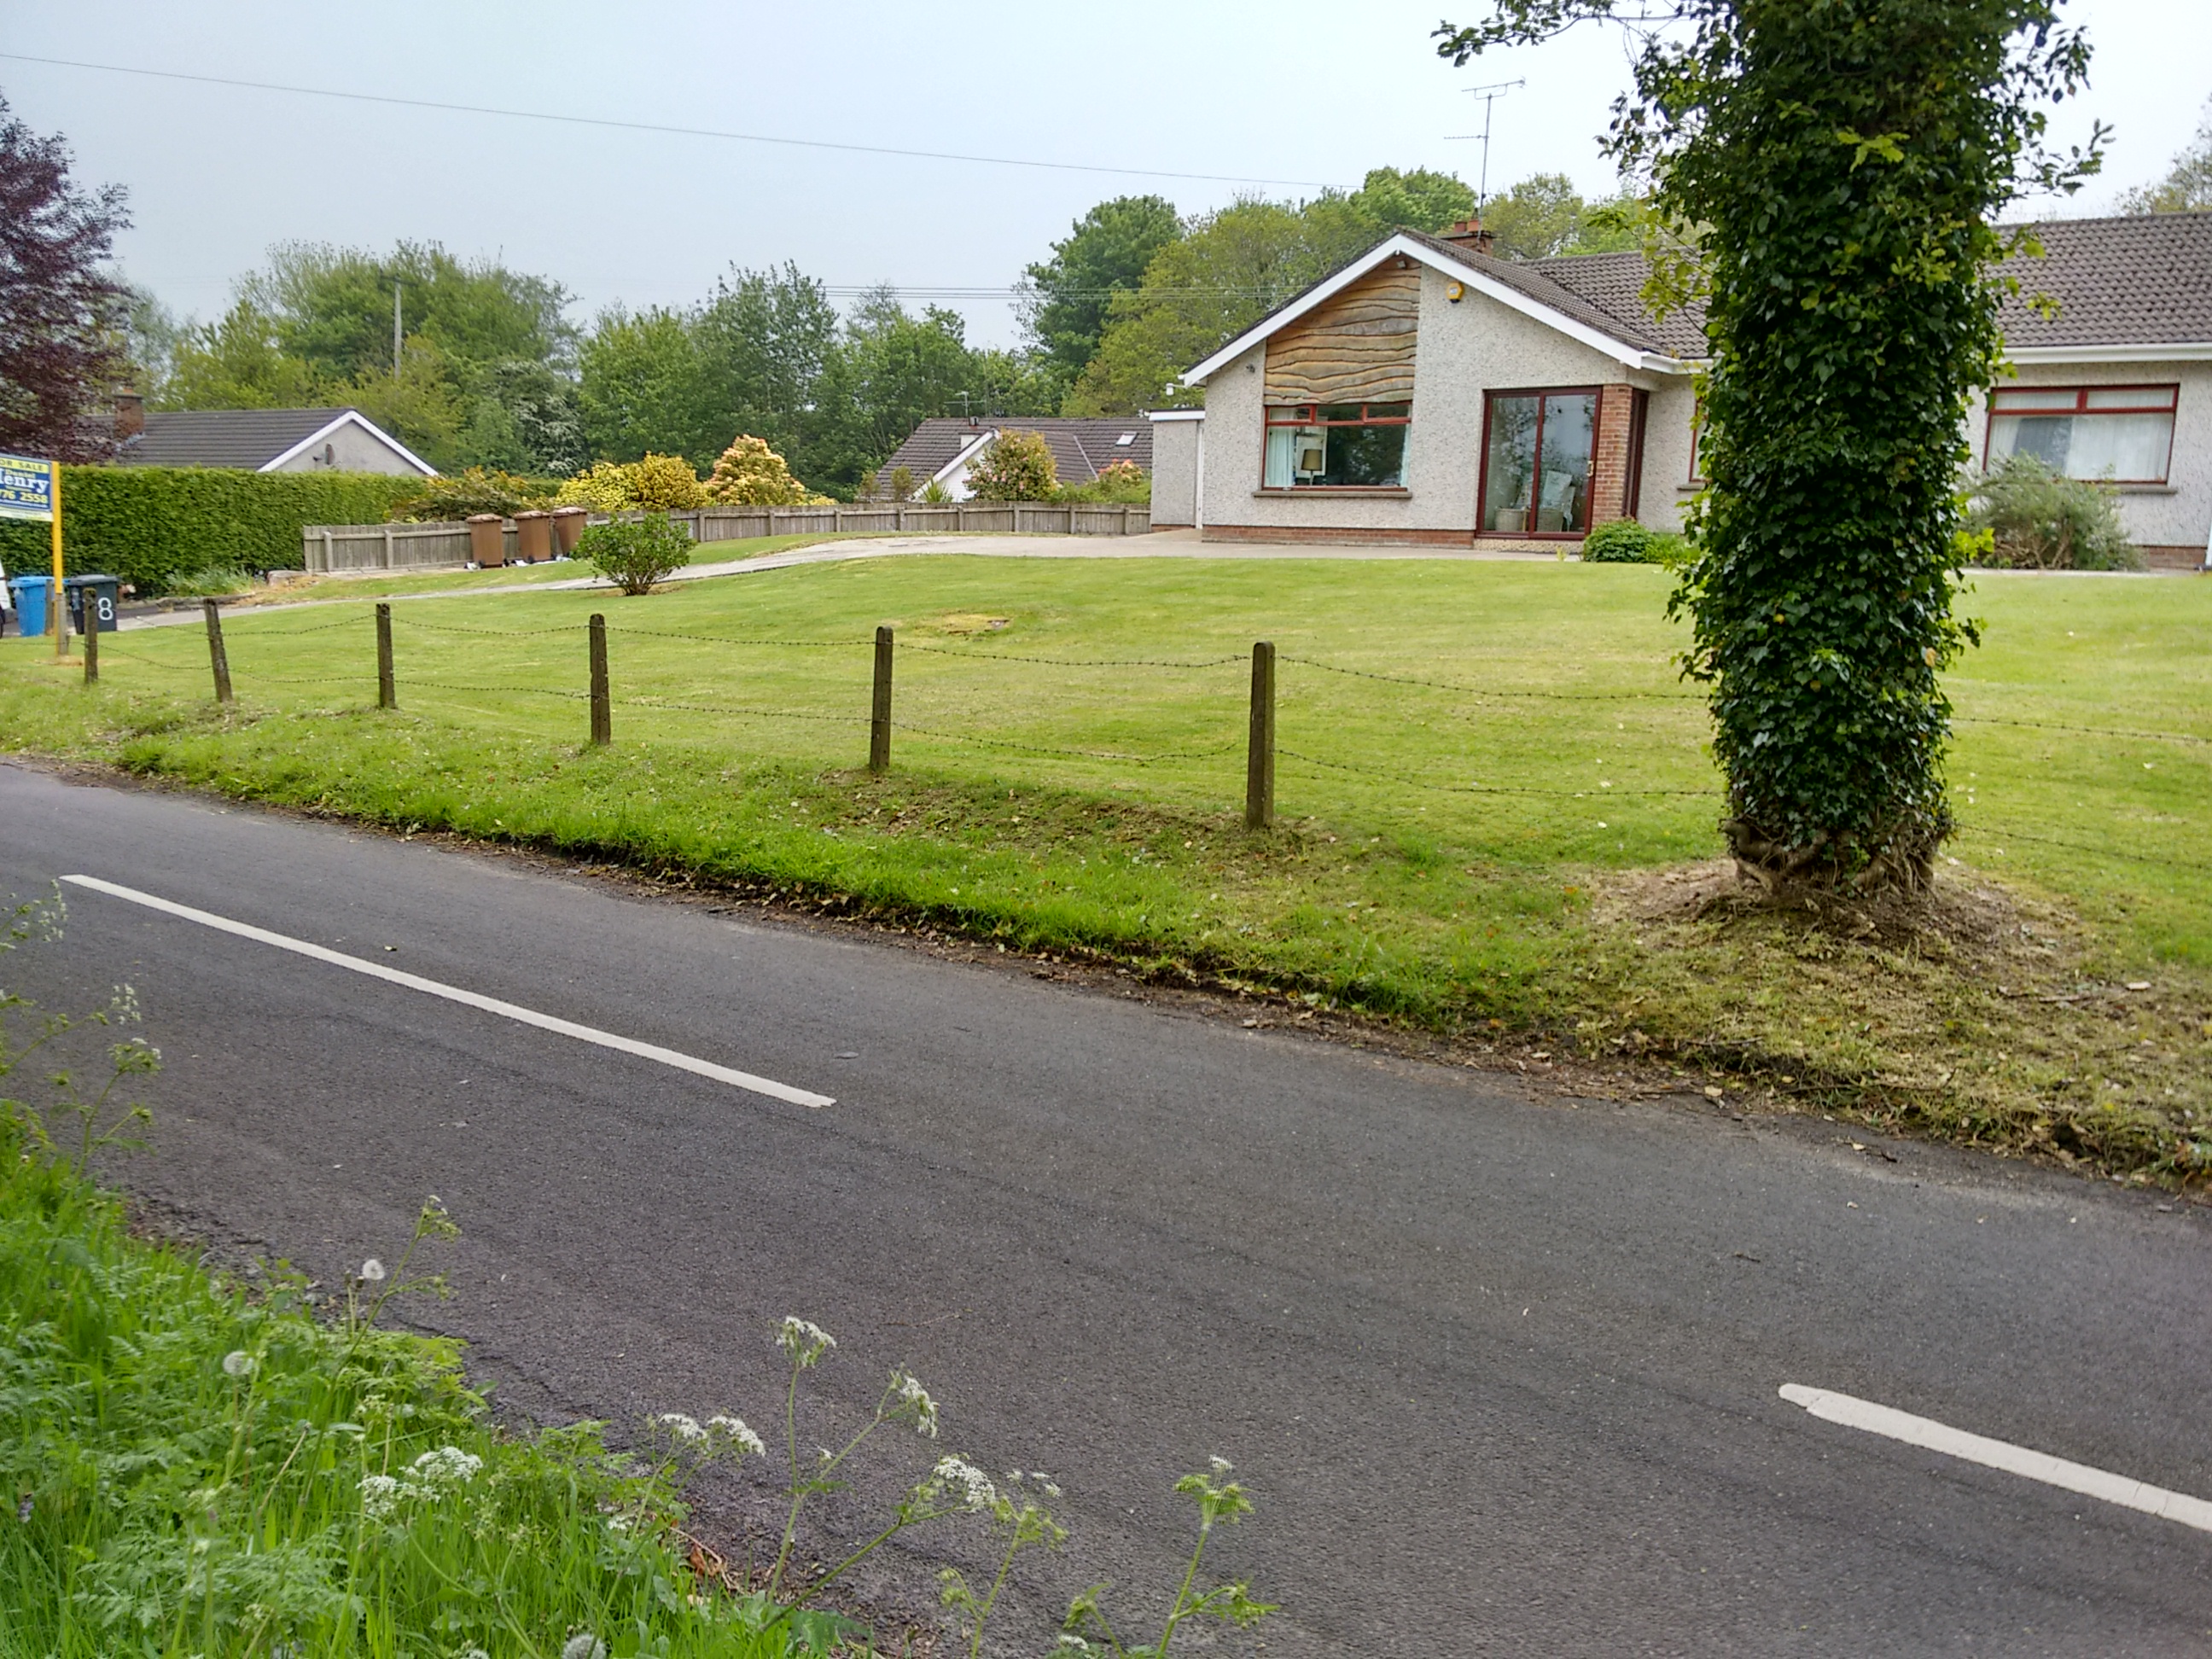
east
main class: Woodland
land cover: Broadleaved woodland
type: floodplain forest
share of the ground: > 75 %
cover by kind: broadleaved forest trees 100 %
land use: Semi-natural and natural areas not in use
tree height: > 5 m
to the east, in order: Broadleaved woodland; Rivers and streams; Broadleaved woodland; Artificial constructions in urban areas; Broadleaved woodland; Rivers and streams; Broadleaved woodland; Grassland without tree/shrub cover; Fences; Abandoned hedges; Paved roads, cycling and walking lanes; Fences; Grassland without tree/shrub cover
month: May
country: GB
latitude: 55.0374
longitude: -7.0221
